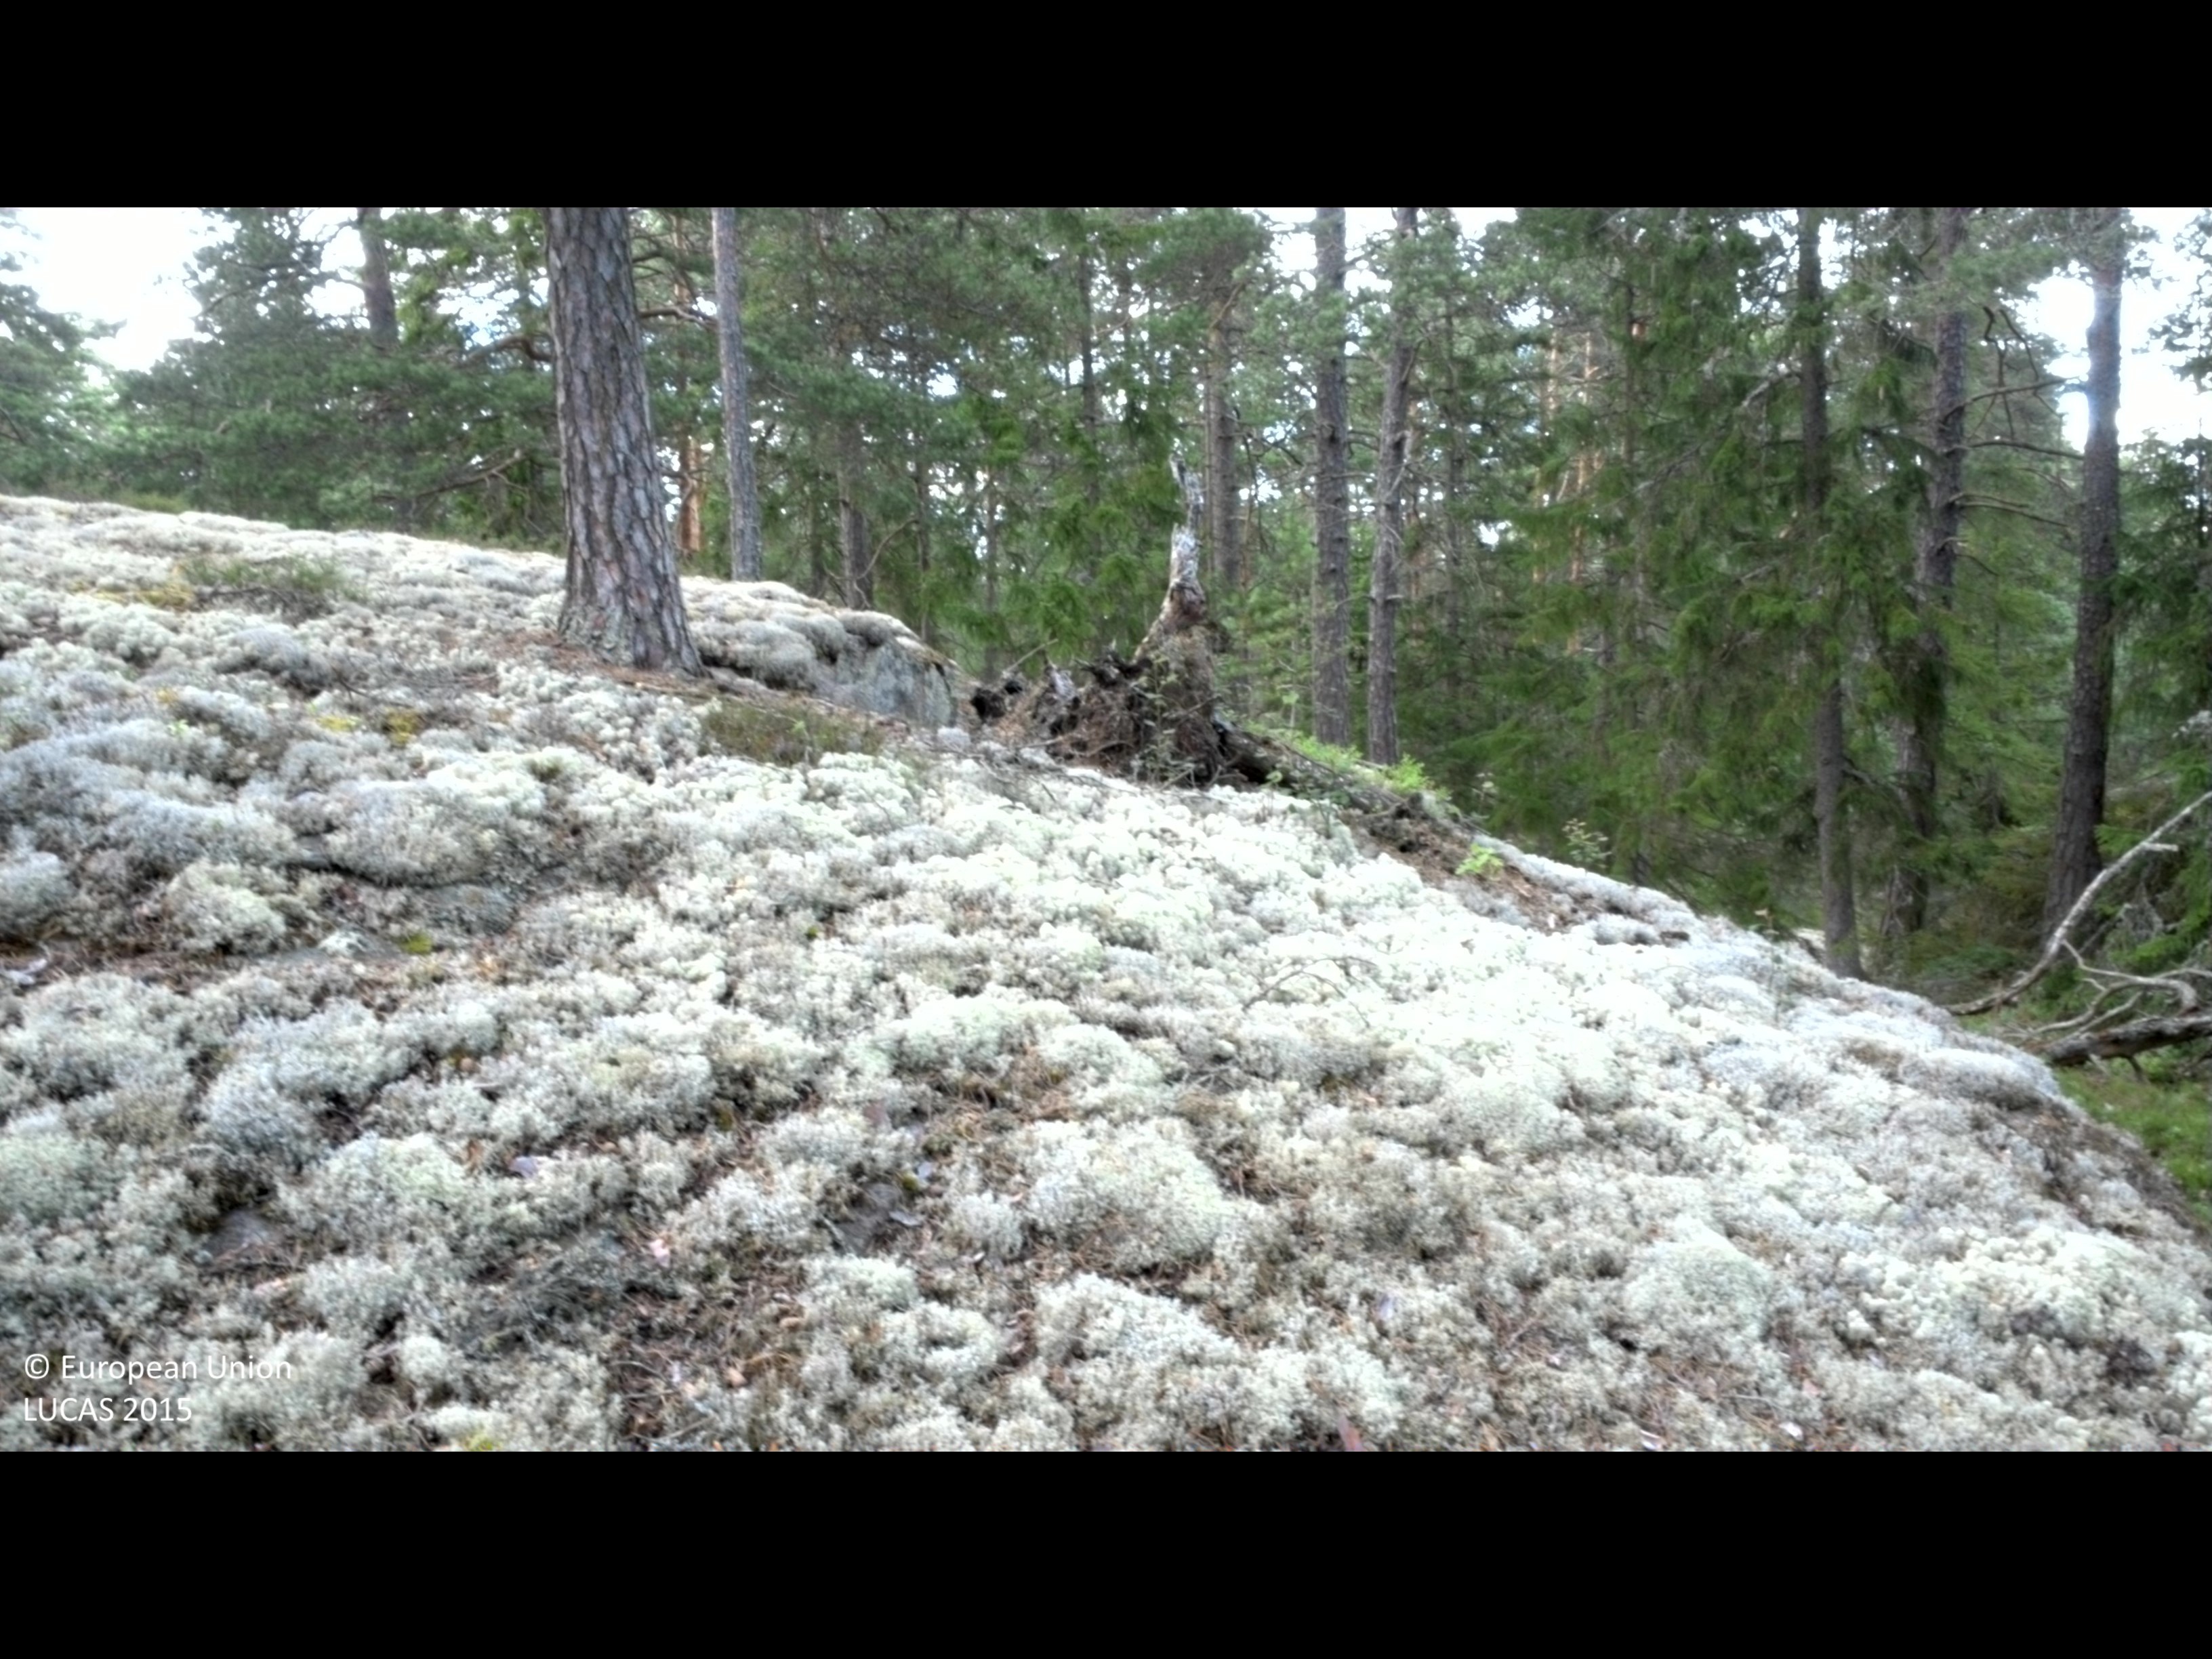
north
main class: Woodland
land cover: Pine dominated coniferous woodland
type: boreal forest
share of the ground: 50 - 75 %
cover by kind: coniferous forest trees 65 %, shrubs 20 %, lichens and mosses 15 %
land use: Forestry
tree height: > 5 m
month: July
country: SE
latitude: 58.4041
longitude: 16.1390
